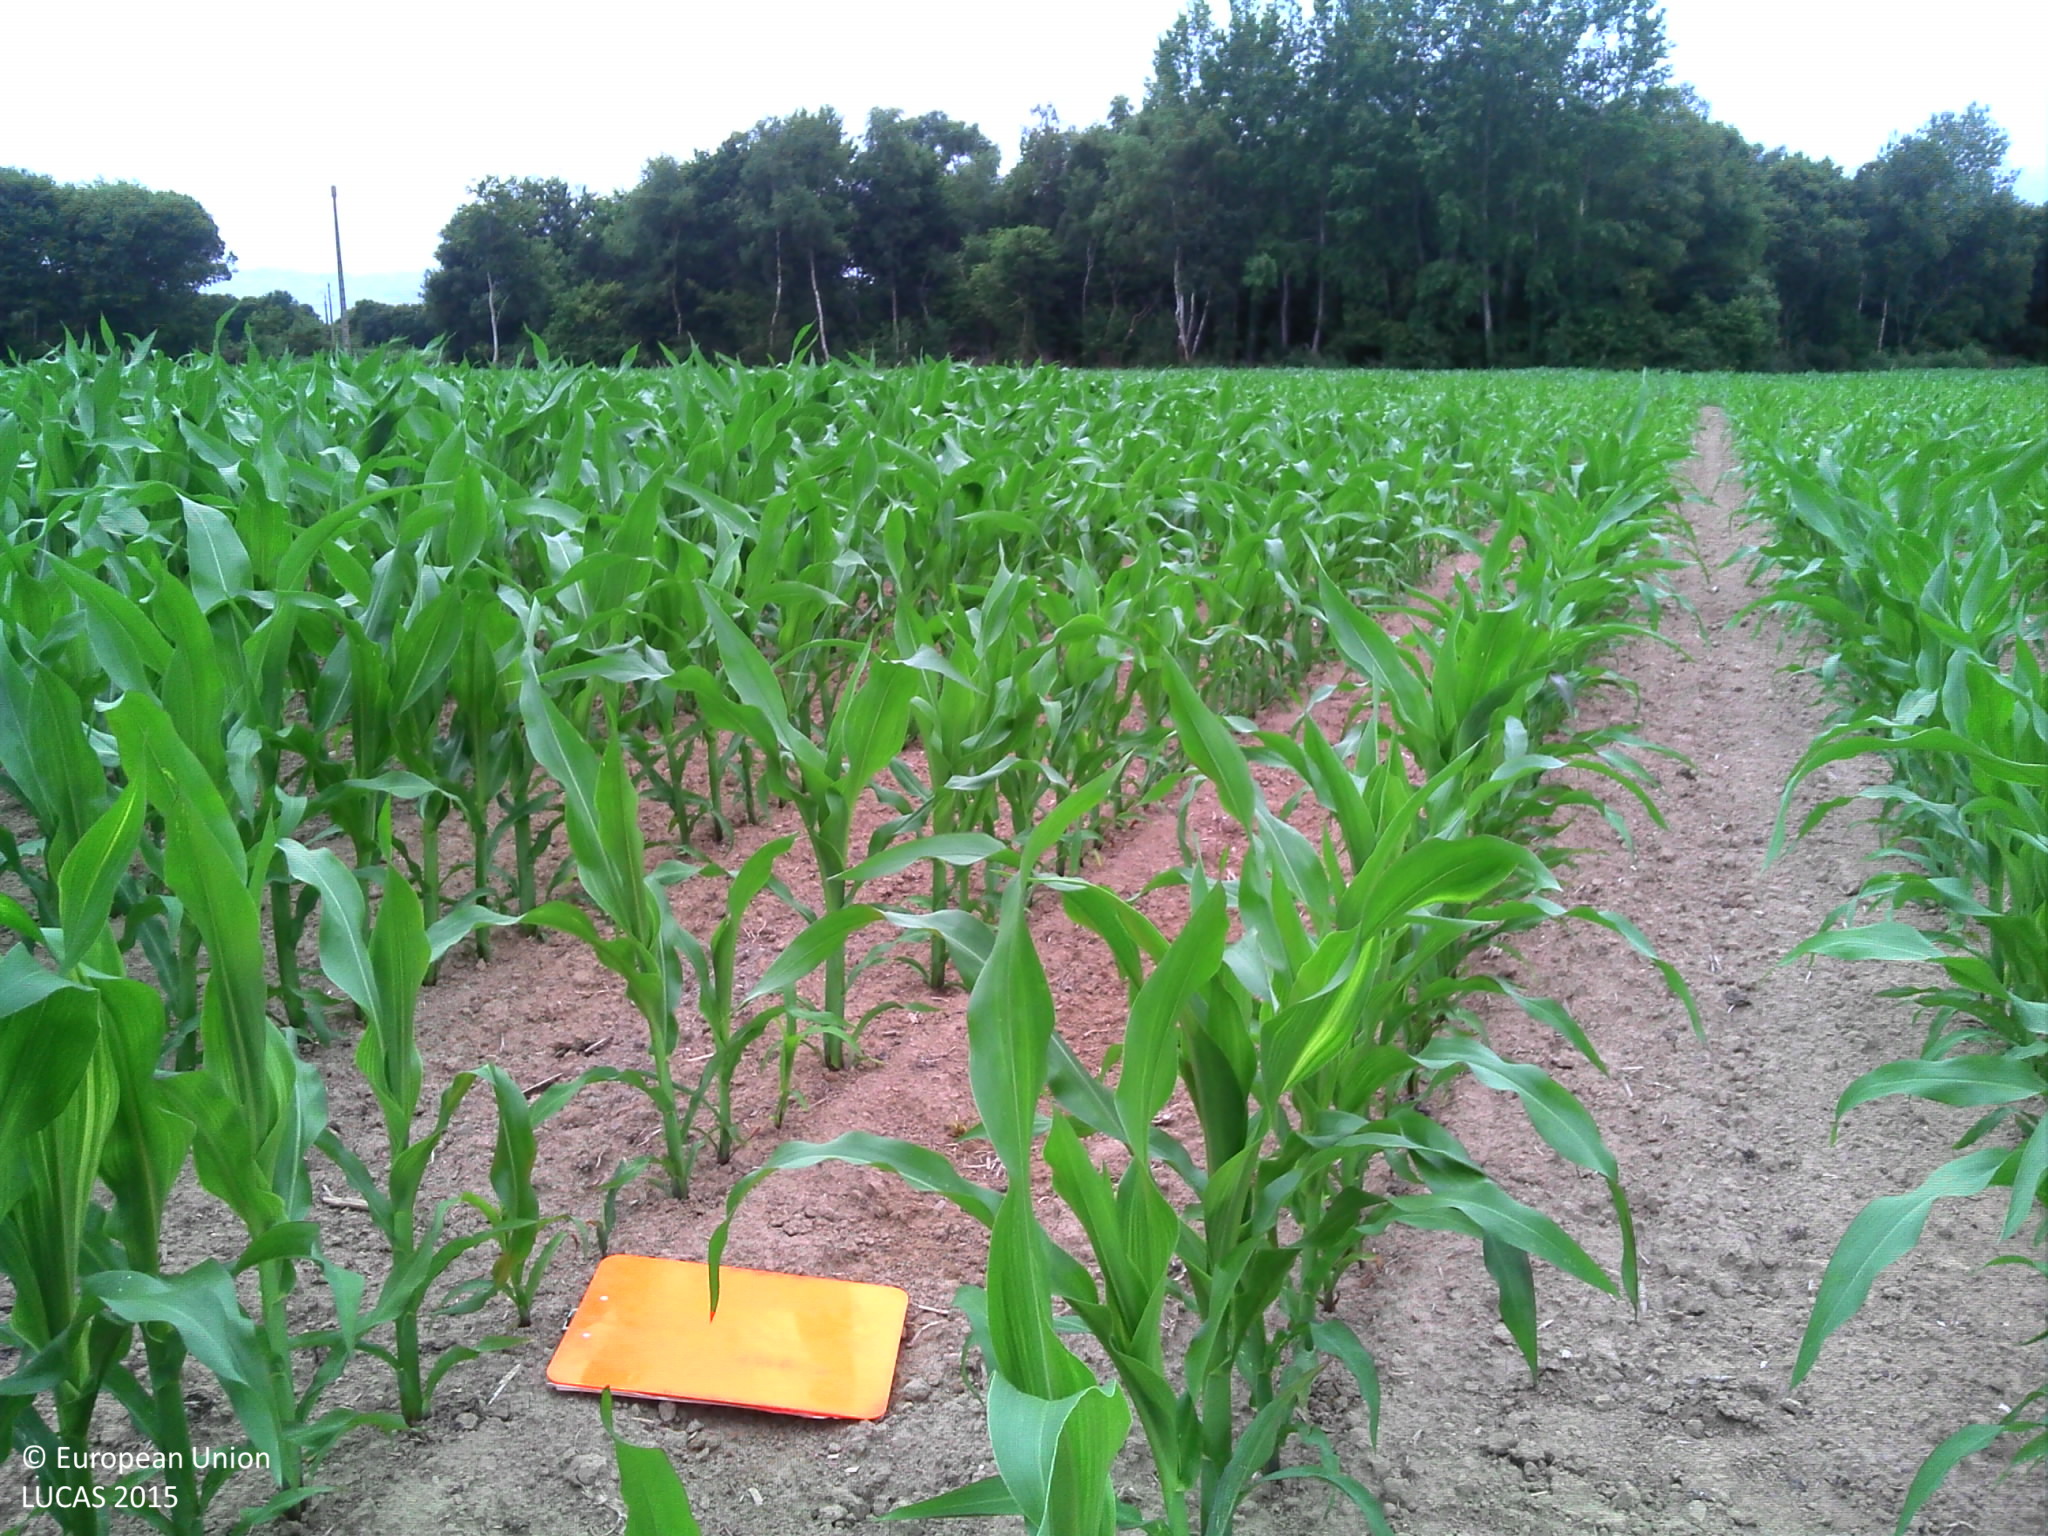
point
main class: Cropland
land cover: Maize
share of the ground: 50 - 75 %
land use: Agriculture (excluding fallow land and kitchen gardens)
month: July
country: FR
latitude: 48.6610
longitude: -3.5348
